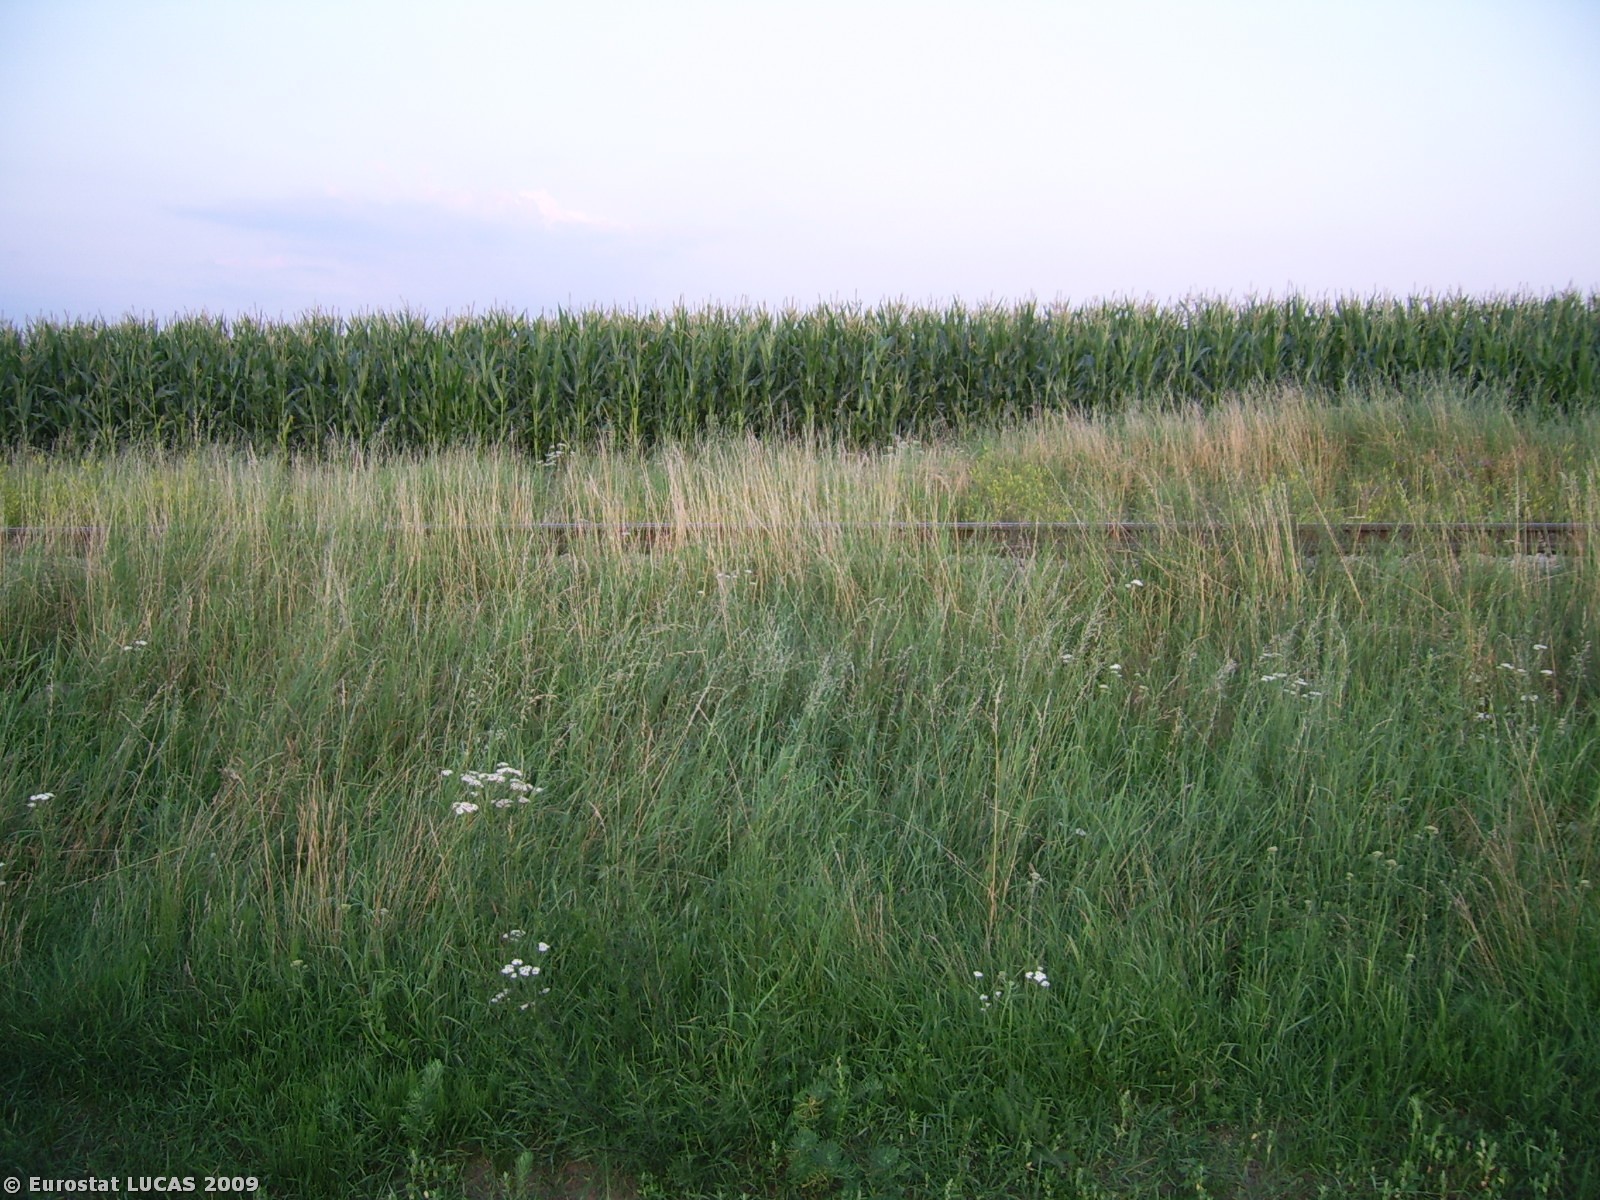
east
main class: Cropland
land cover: Triticale
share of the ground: > 75 %
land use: Agriculture (excluding fallow land and kitchen gardens)
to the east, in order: Triticale; Shrubland without tree cover; Inland water bodies; Shrubland without tree cover
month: July
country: PL
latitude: 51.6608
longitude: 17.3704
